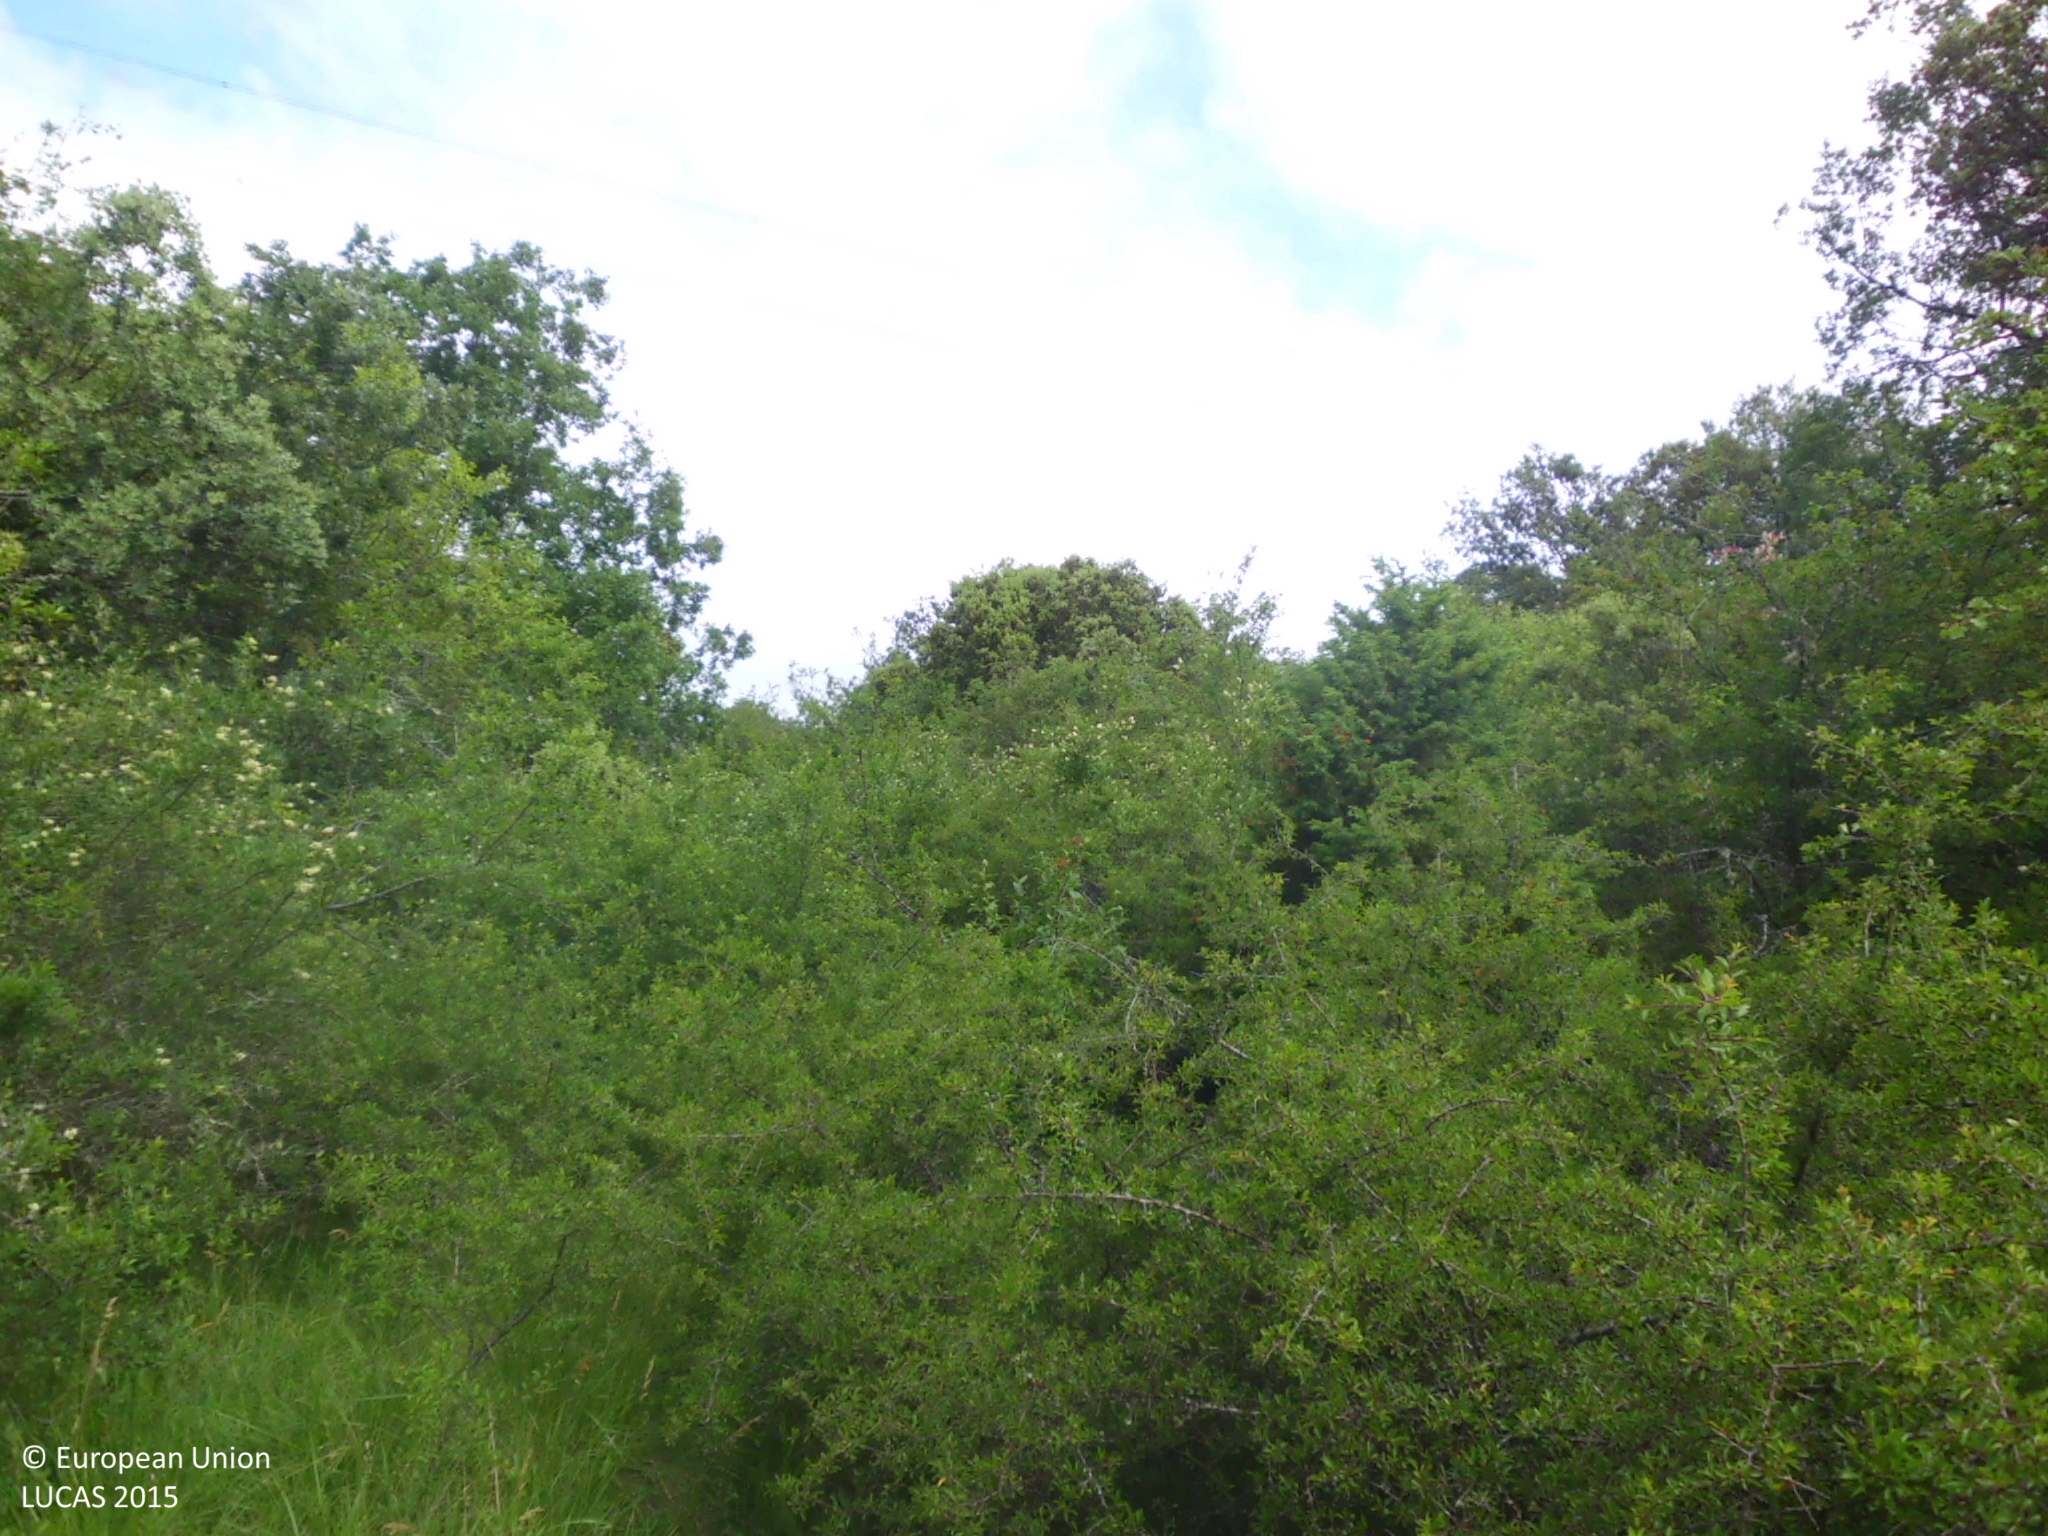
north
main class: Woodland
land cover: Broadleaved woodland
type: broadleaved evergreen forest
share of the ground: 50 - 75 %
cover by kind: broadleaved forest trees 50 %, shrubs 30 %, herbaceous plants 20 %
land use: Semi-natural and natural areas not in use
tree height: > 5 m
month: June
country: ES
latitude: 42.5075
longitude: -3.4084
